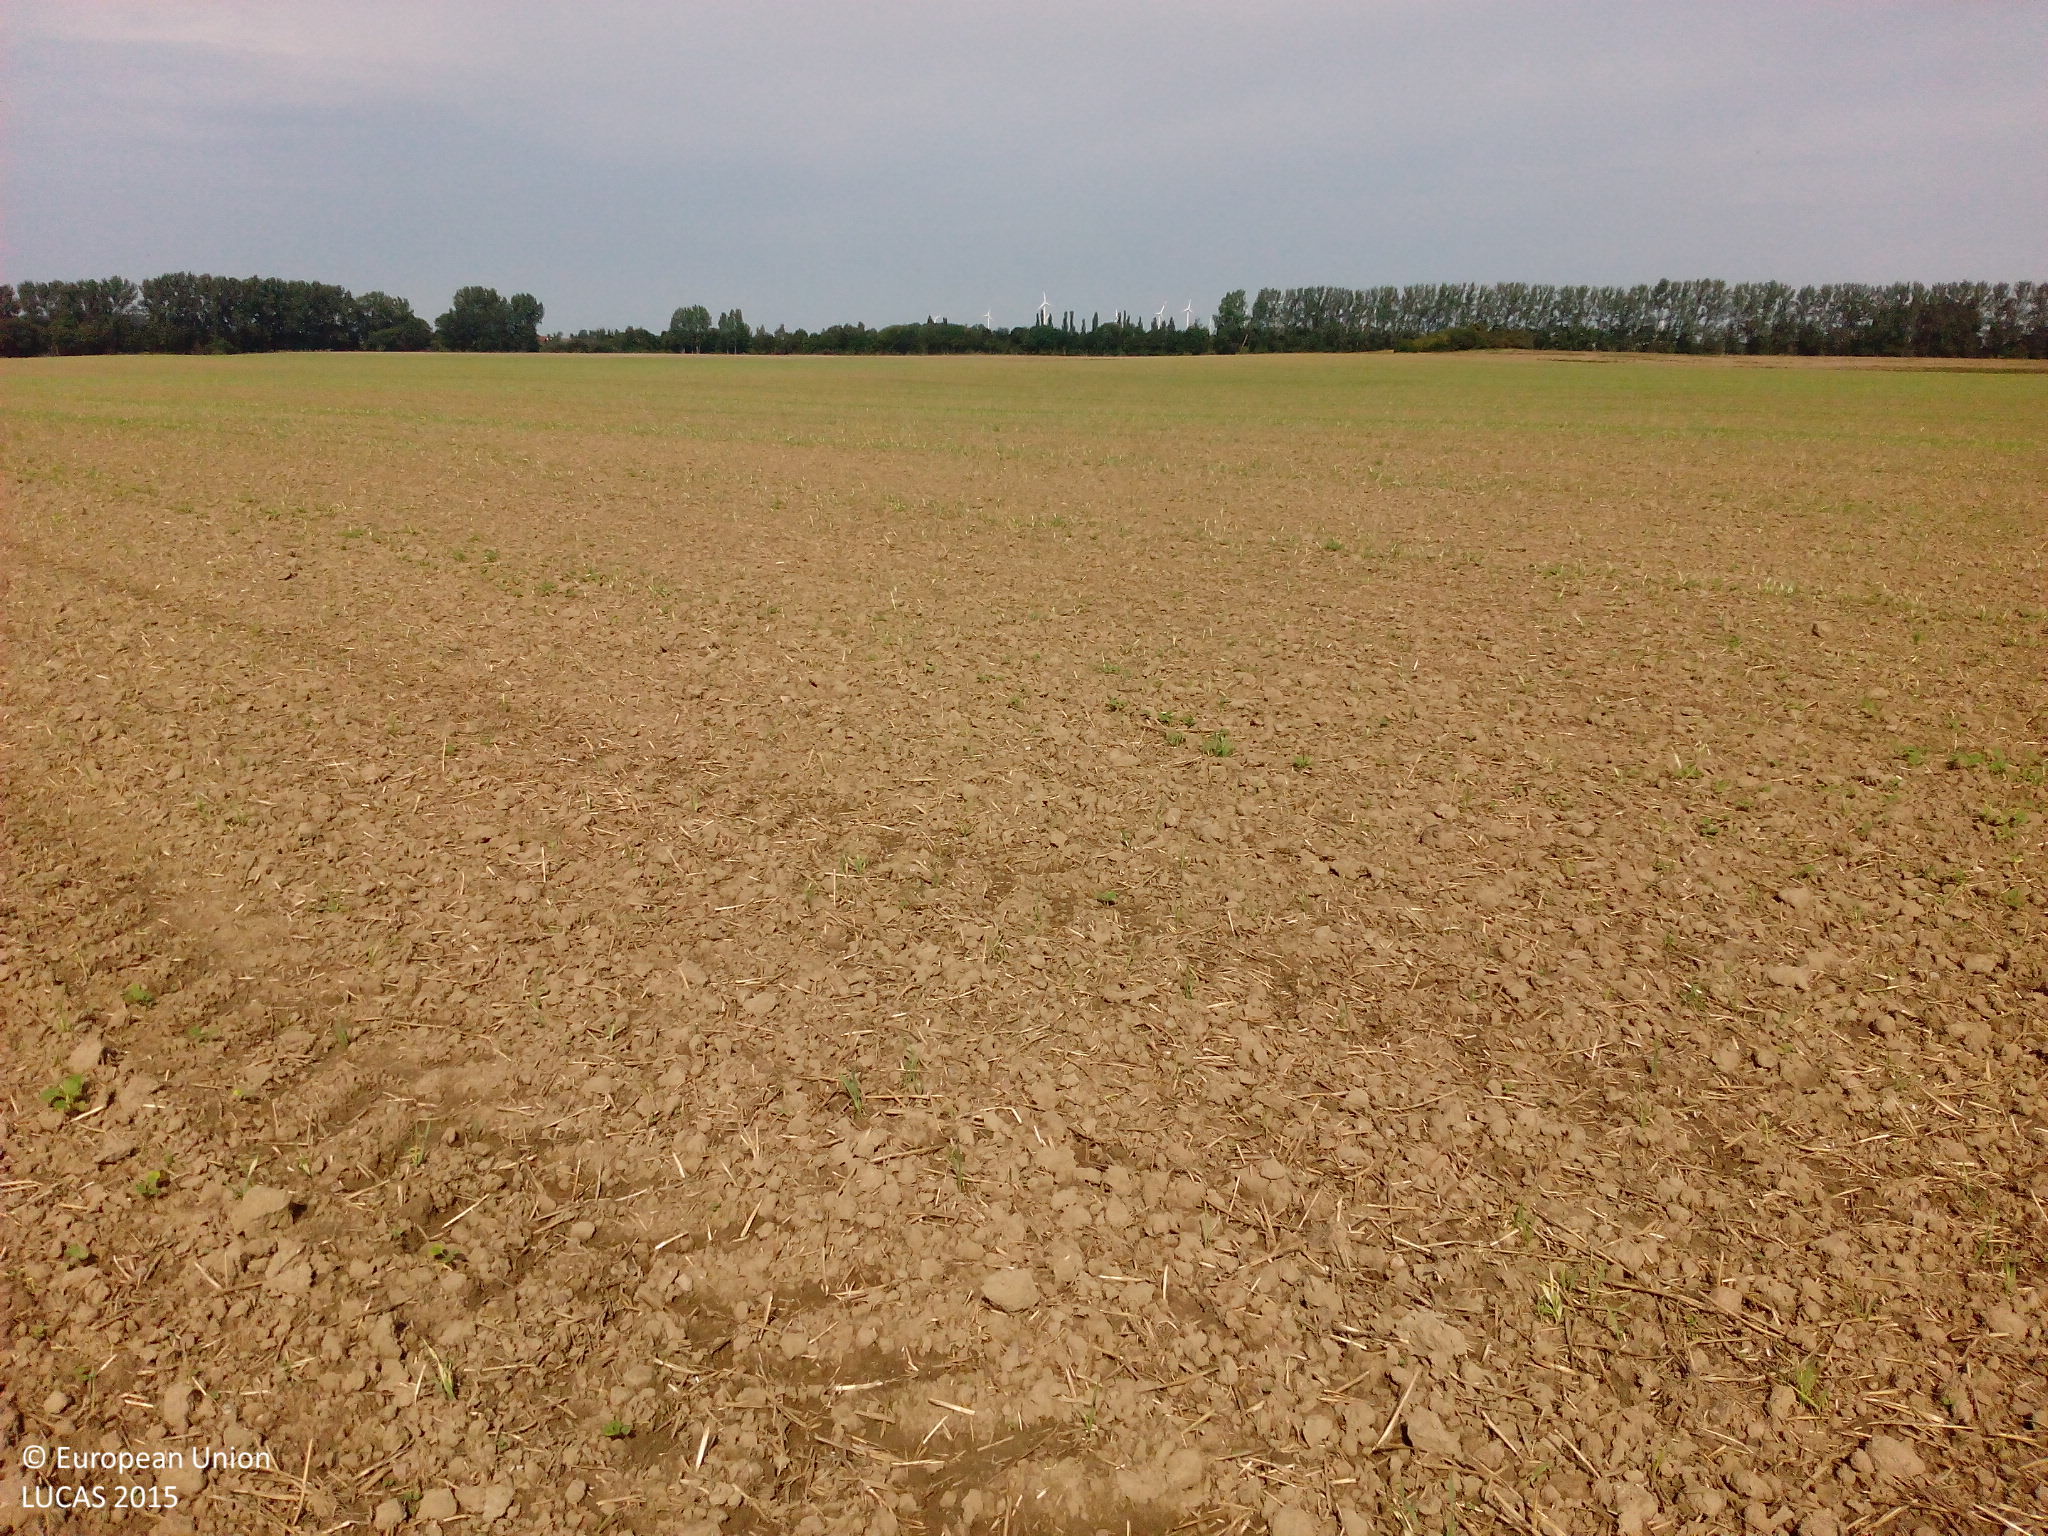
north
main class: Cropland
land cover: Rape and turnip rape
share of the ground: < 10 %
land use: Agriculture (excluding fallow land and kitchen gardens)
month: August
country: DE
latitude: 54.2367
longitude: 12.6226
